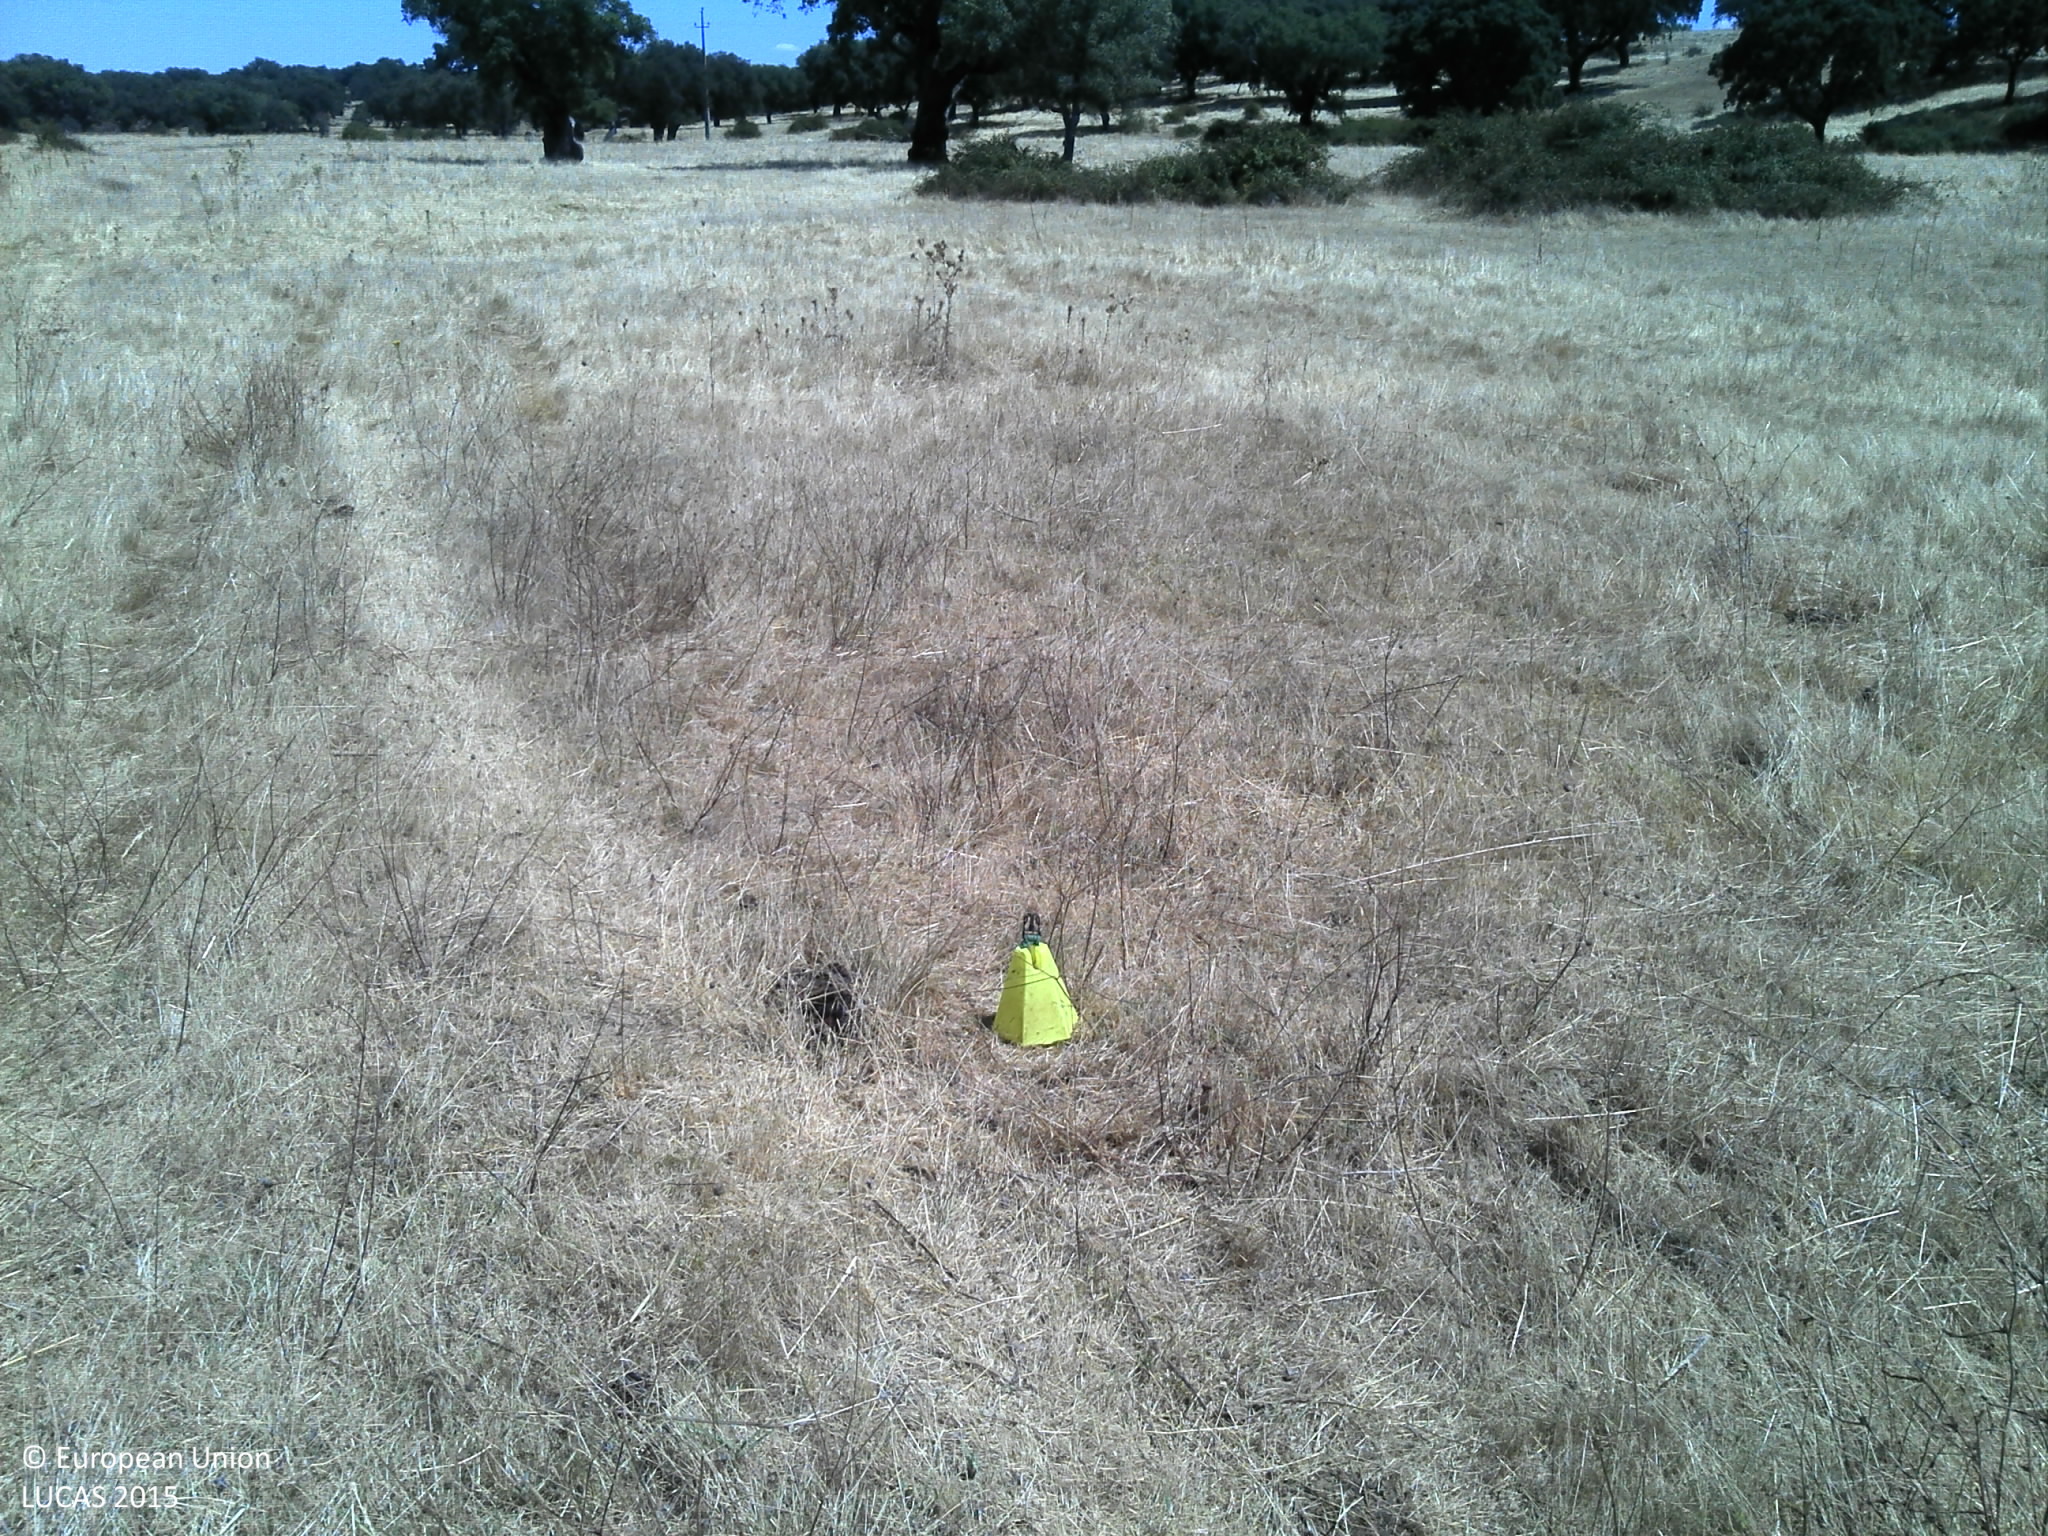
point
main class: Grassland
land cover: Grassland without tree/shrub cover
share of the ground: 50 - 75 %
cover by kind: herbaceous plants 60 %, unconsolidated bare surface 40 %
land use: Agriculture (excluding fallow land and kitchen gardens)
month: July
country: PT
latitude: 39.1899
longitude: -7.4411
